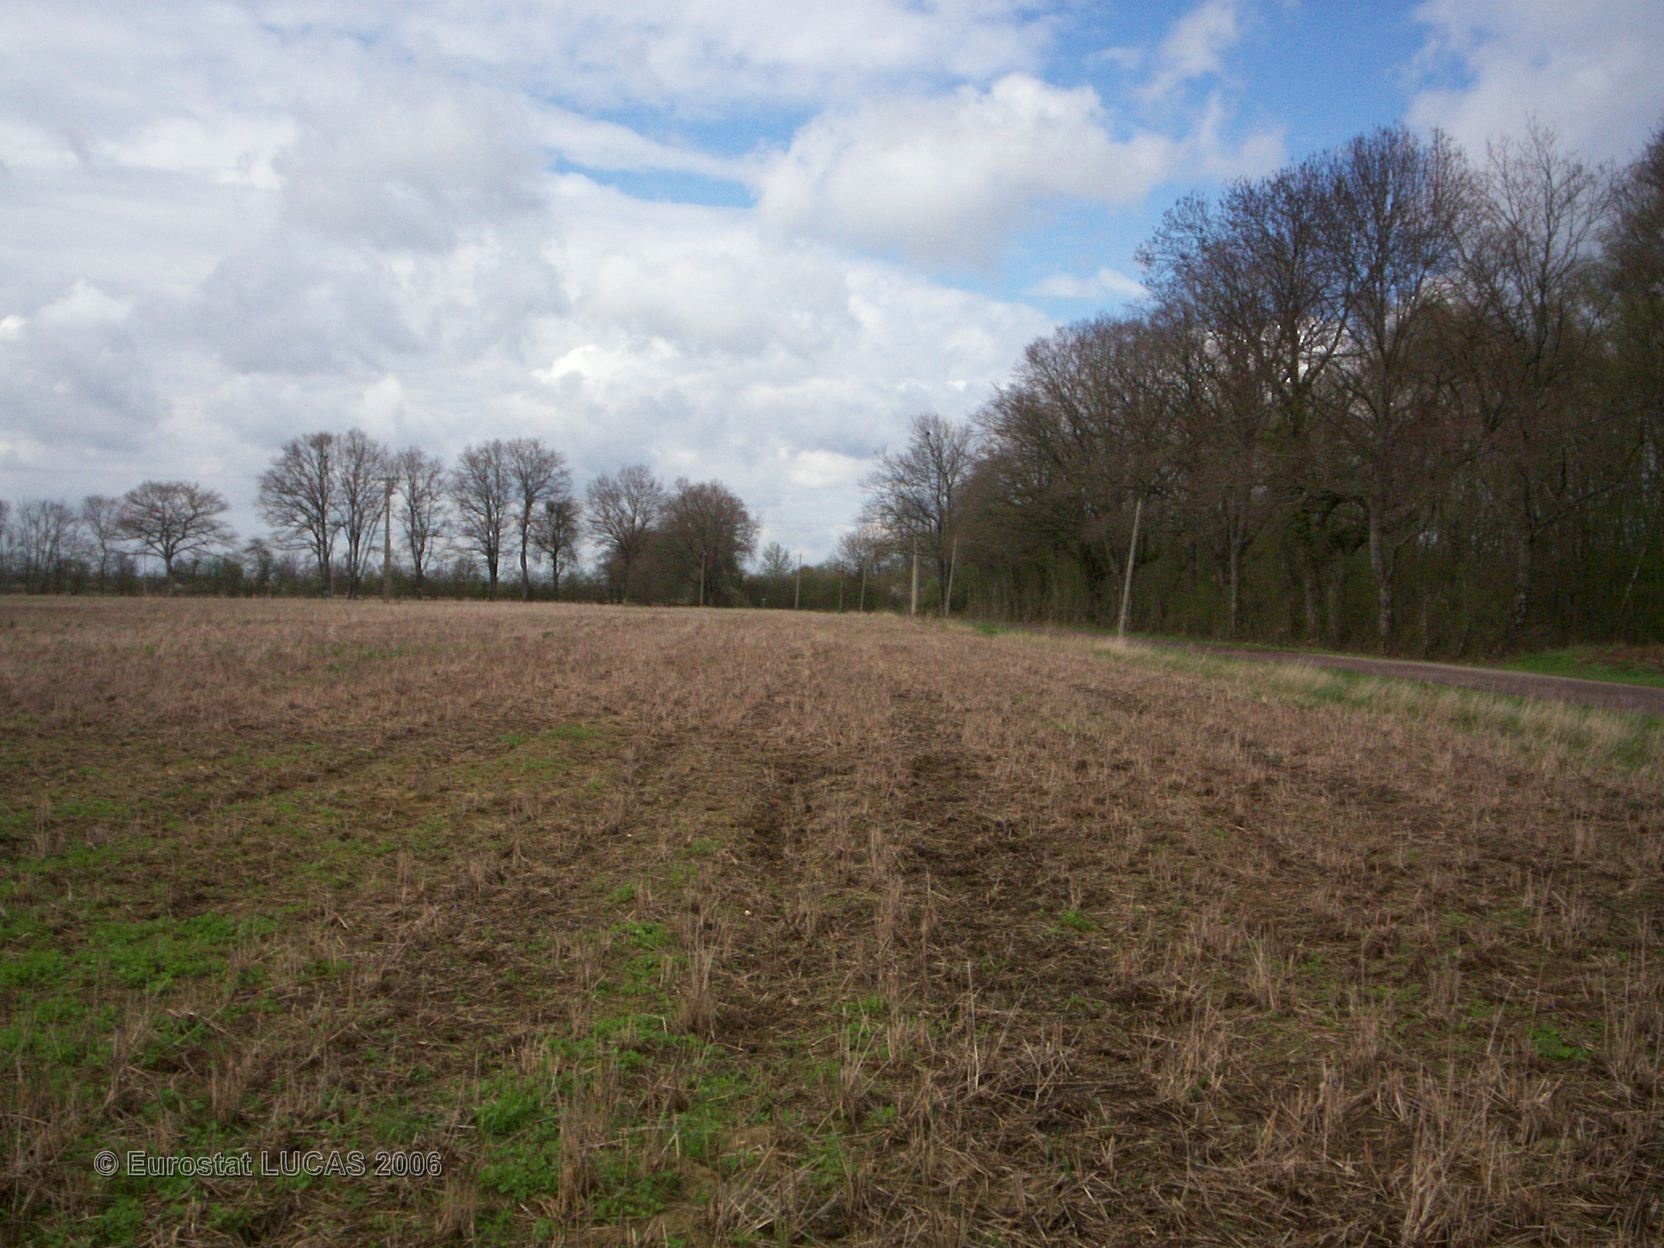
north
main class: Cropland
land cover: Other leguminous and mixtures for fodder
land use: Agriculture (excluding fallow land and kitchen gardens)
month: May
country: FR
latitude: 47.4772
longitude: 3.0013
